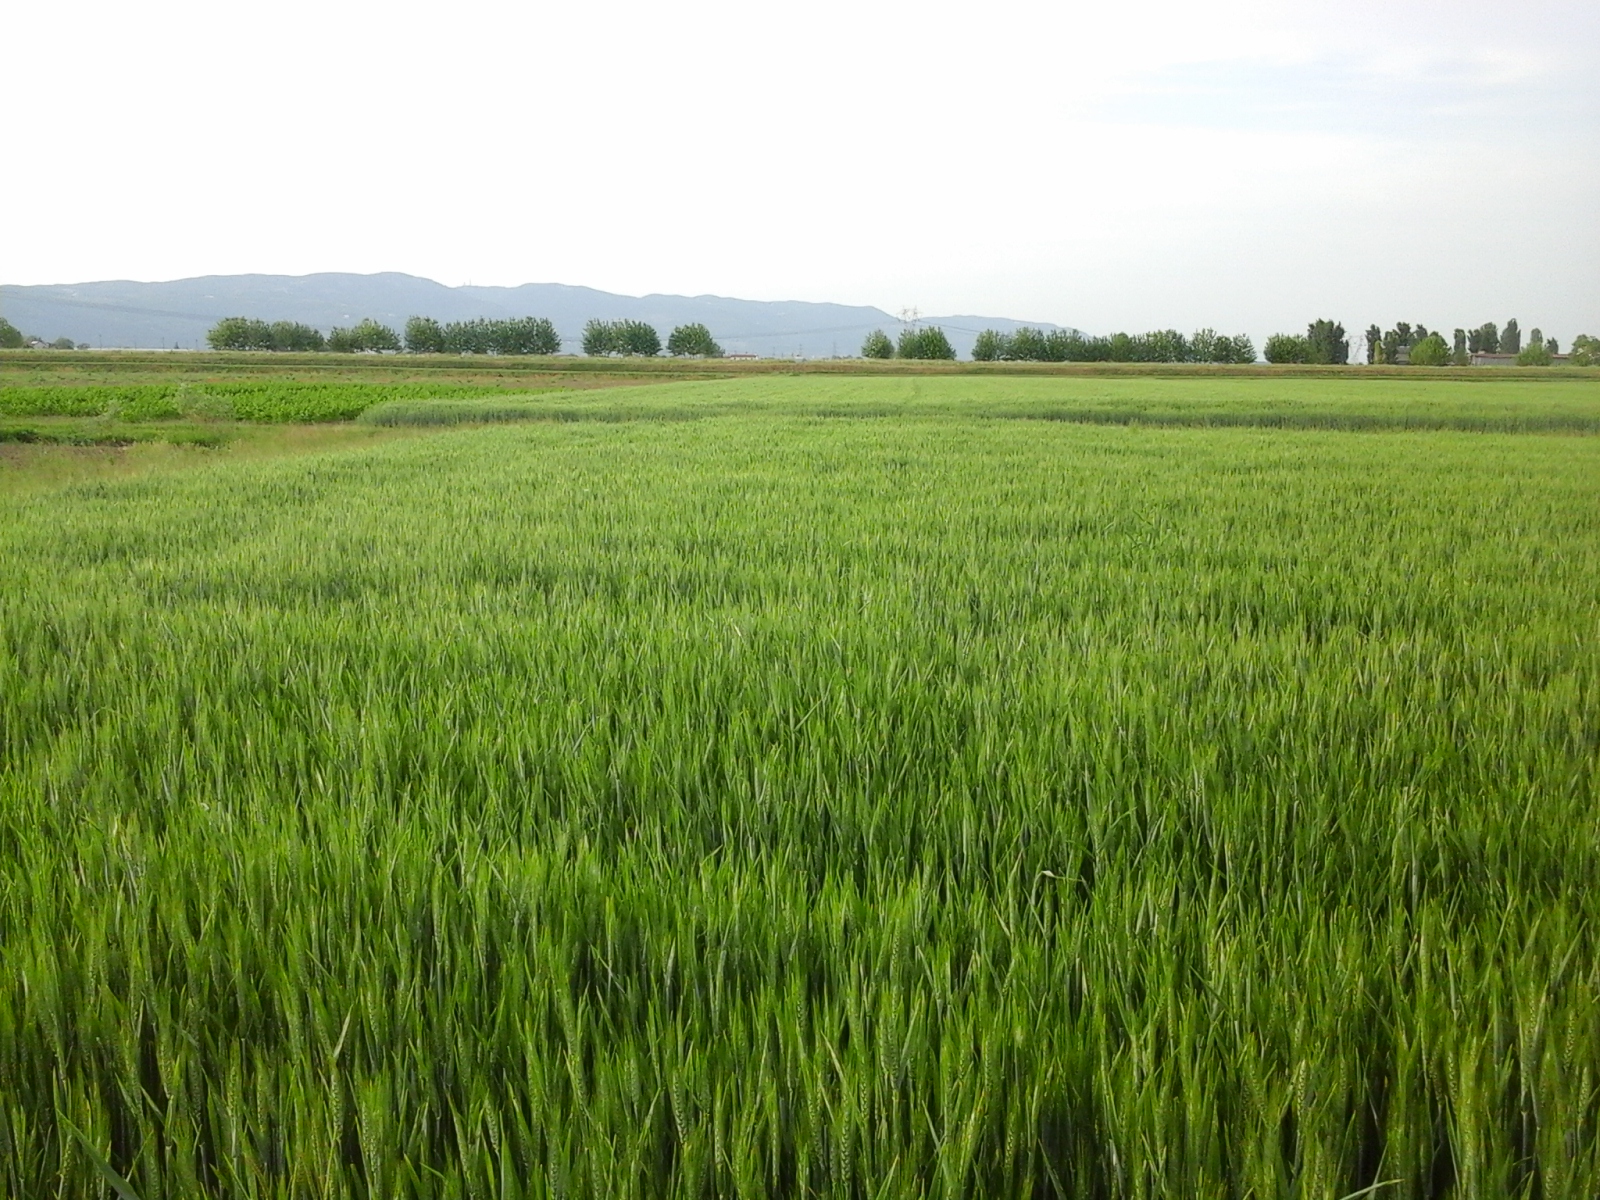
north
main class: Cropland
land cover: Common wheat
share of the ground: > 75 %
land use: Agriculture (excluding fallow land and kitchen gardens)
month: May
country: IT
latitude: 45.3490
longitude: 11.5417
